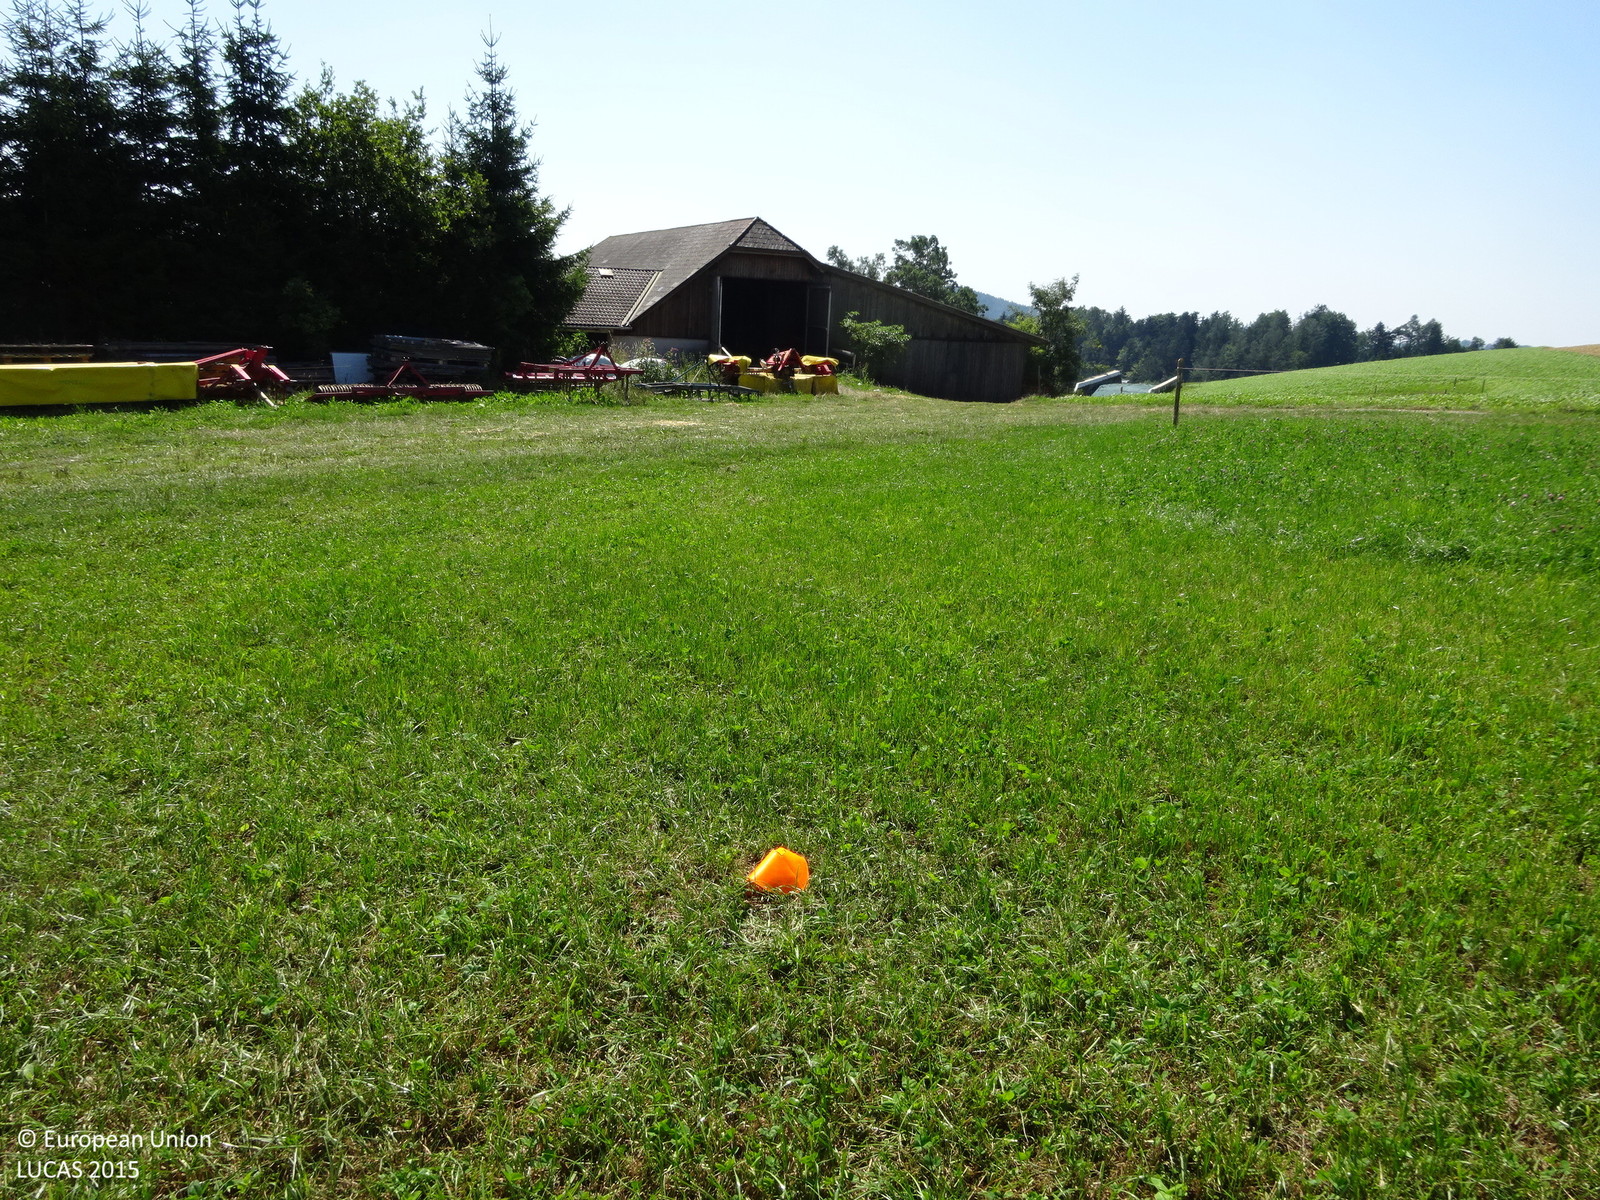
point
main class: Cropland
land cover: Temporary grasslands
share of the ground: > 75 %
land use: Agriculture (excluding fallow land and kitchen gardens)
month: August
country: AT
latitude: 47.4939
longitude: 16.1217
